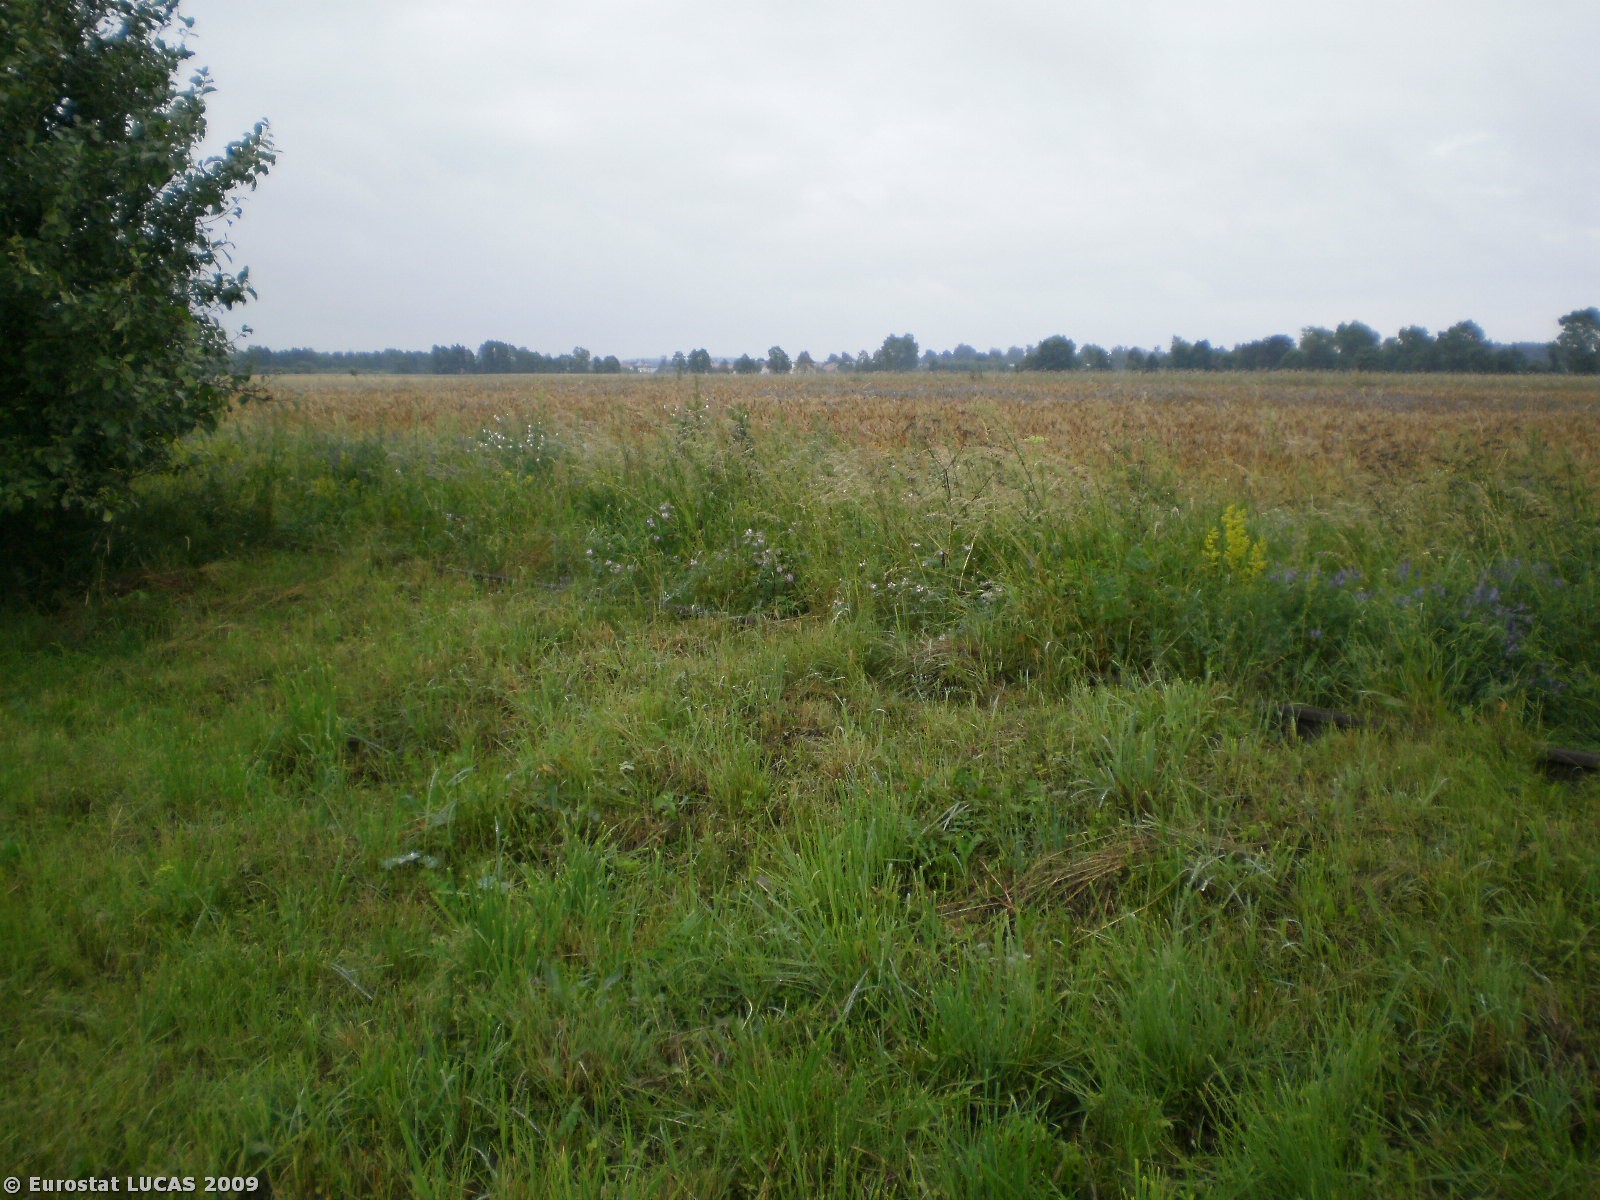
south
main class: Grassland
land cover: Grassland without tree/shrub cover
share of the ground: > 75 %
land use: Agriculture (excluding fallow land and kitchen gardens)
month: July
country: PL
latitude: 53.0940
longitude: 20.4454
